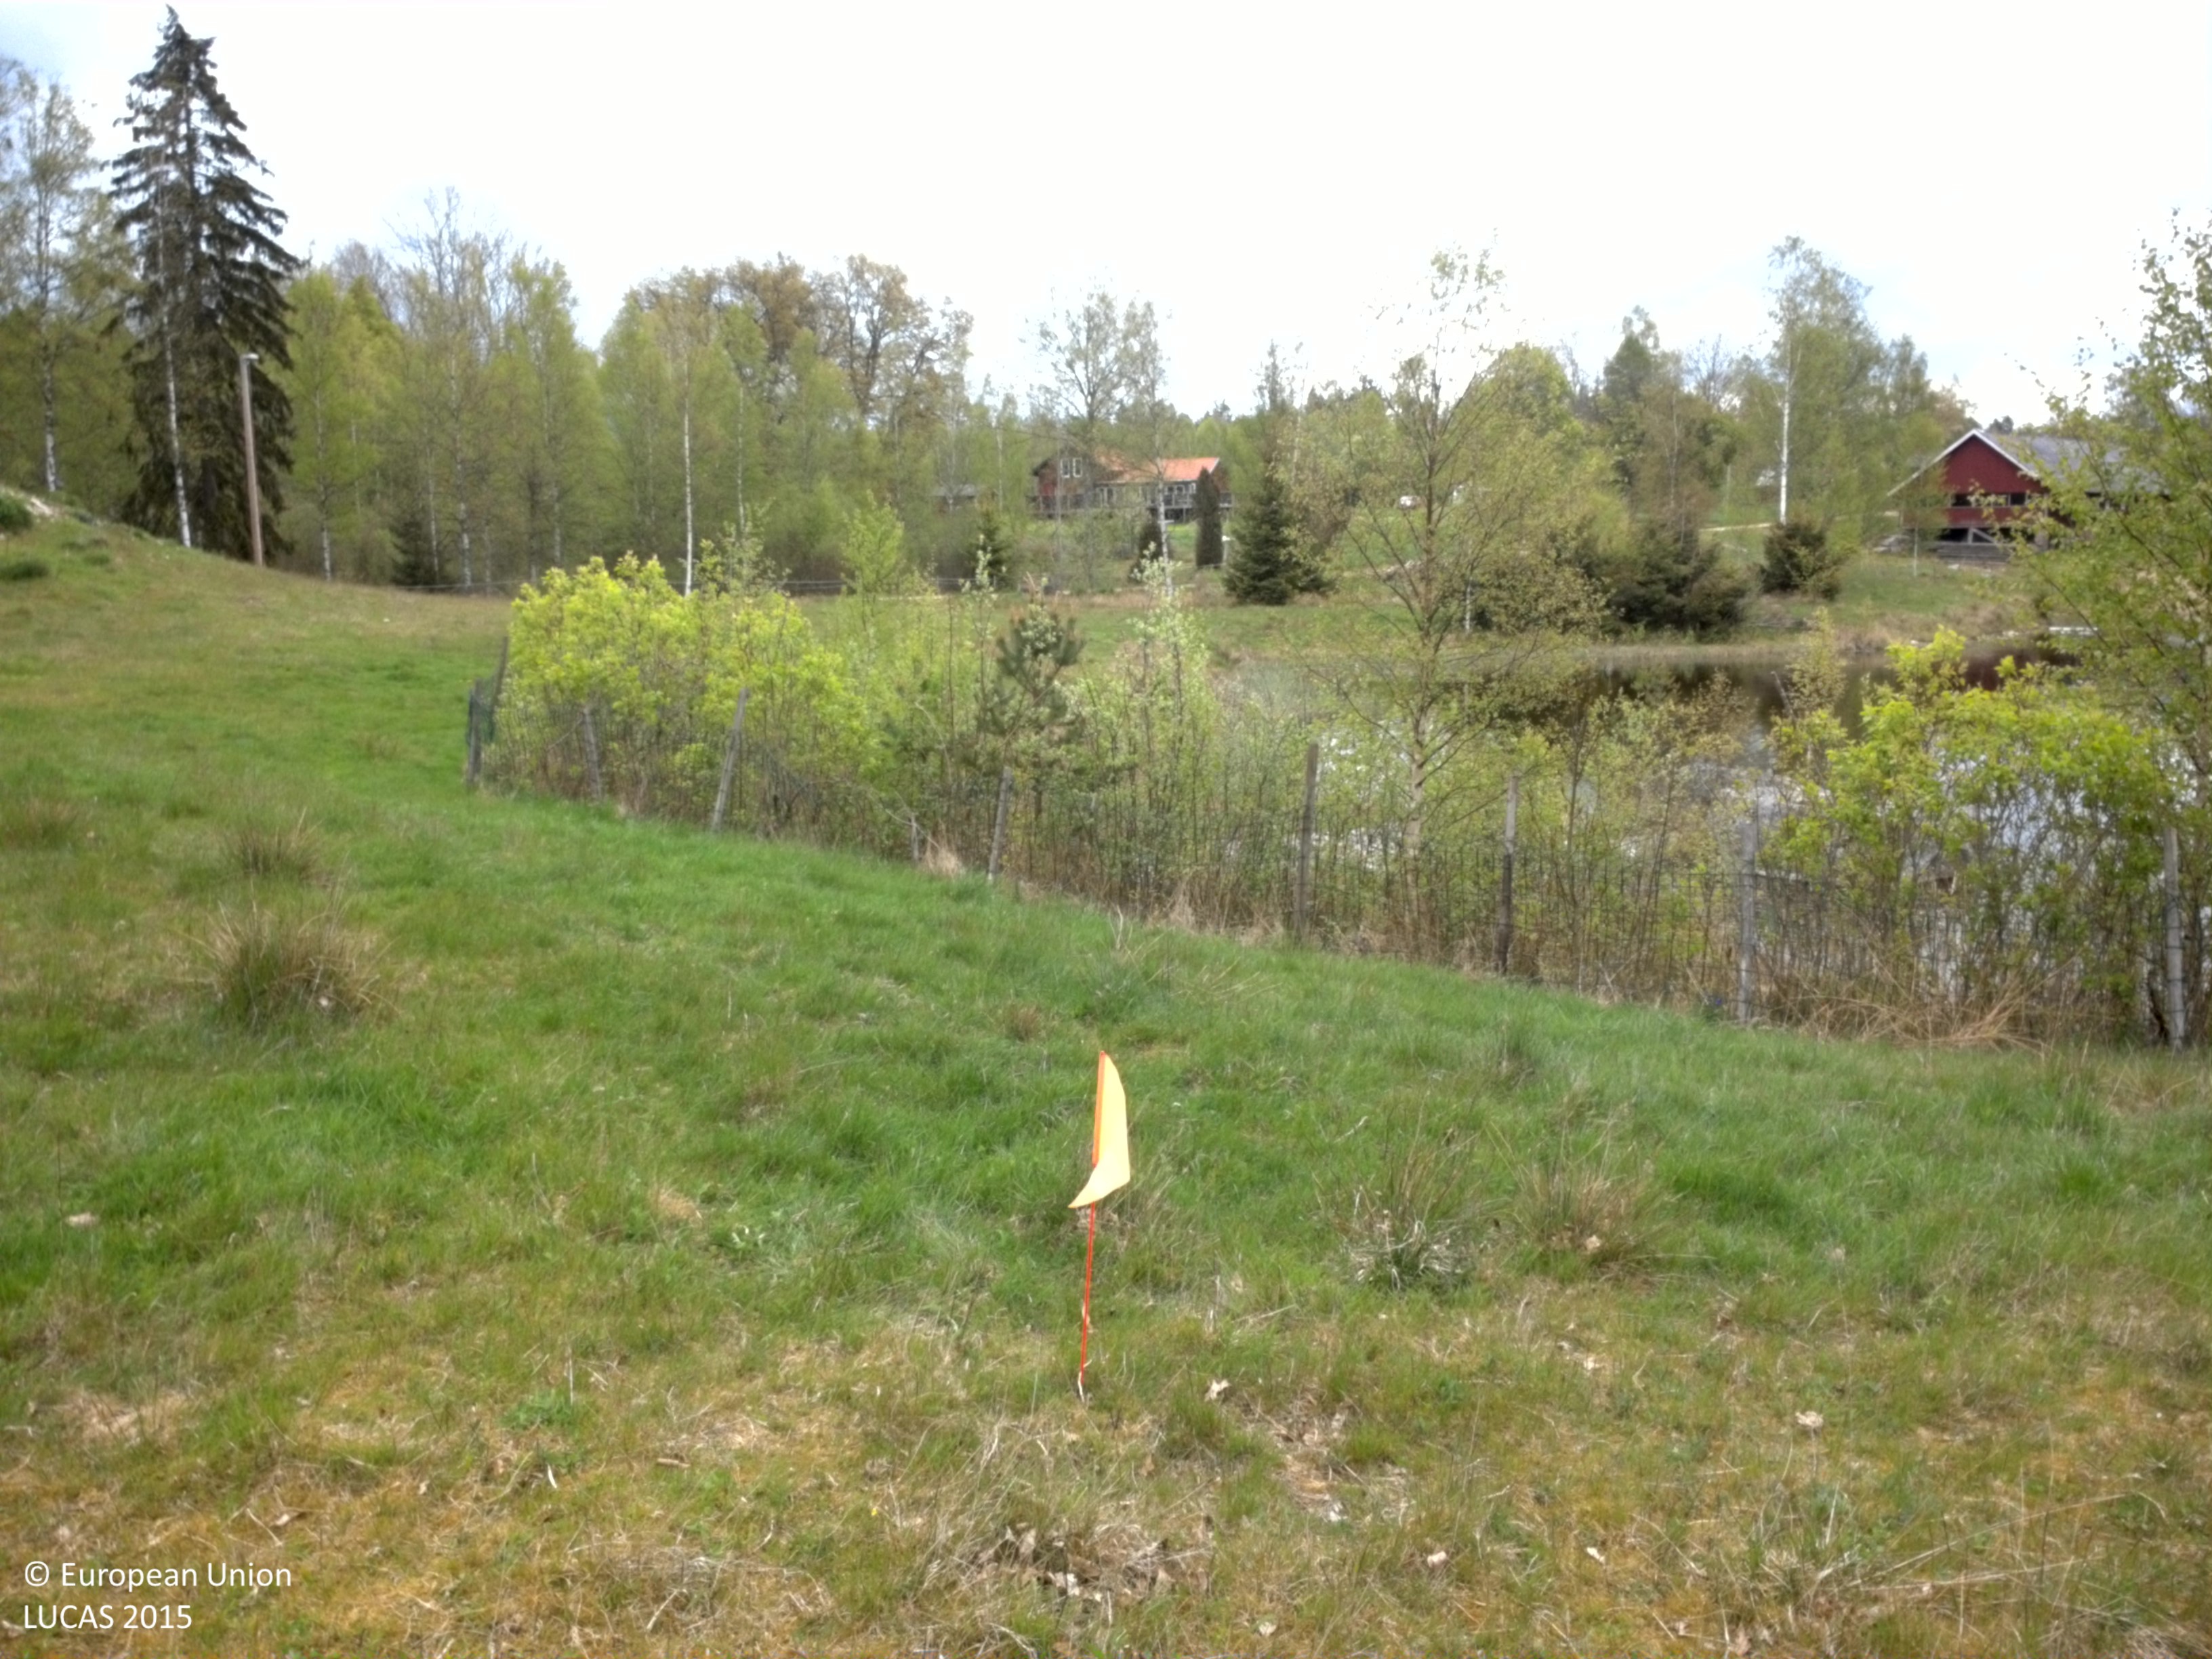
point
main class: Grassland
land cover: Grassland without tree/shrub cover
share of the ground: > 75 %
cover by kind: herbaceous plants 100 %
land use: Agriculture (excluding fallow land and kitchen gardens)
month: May
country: SE
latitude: 56.7984
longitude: 15.3197
